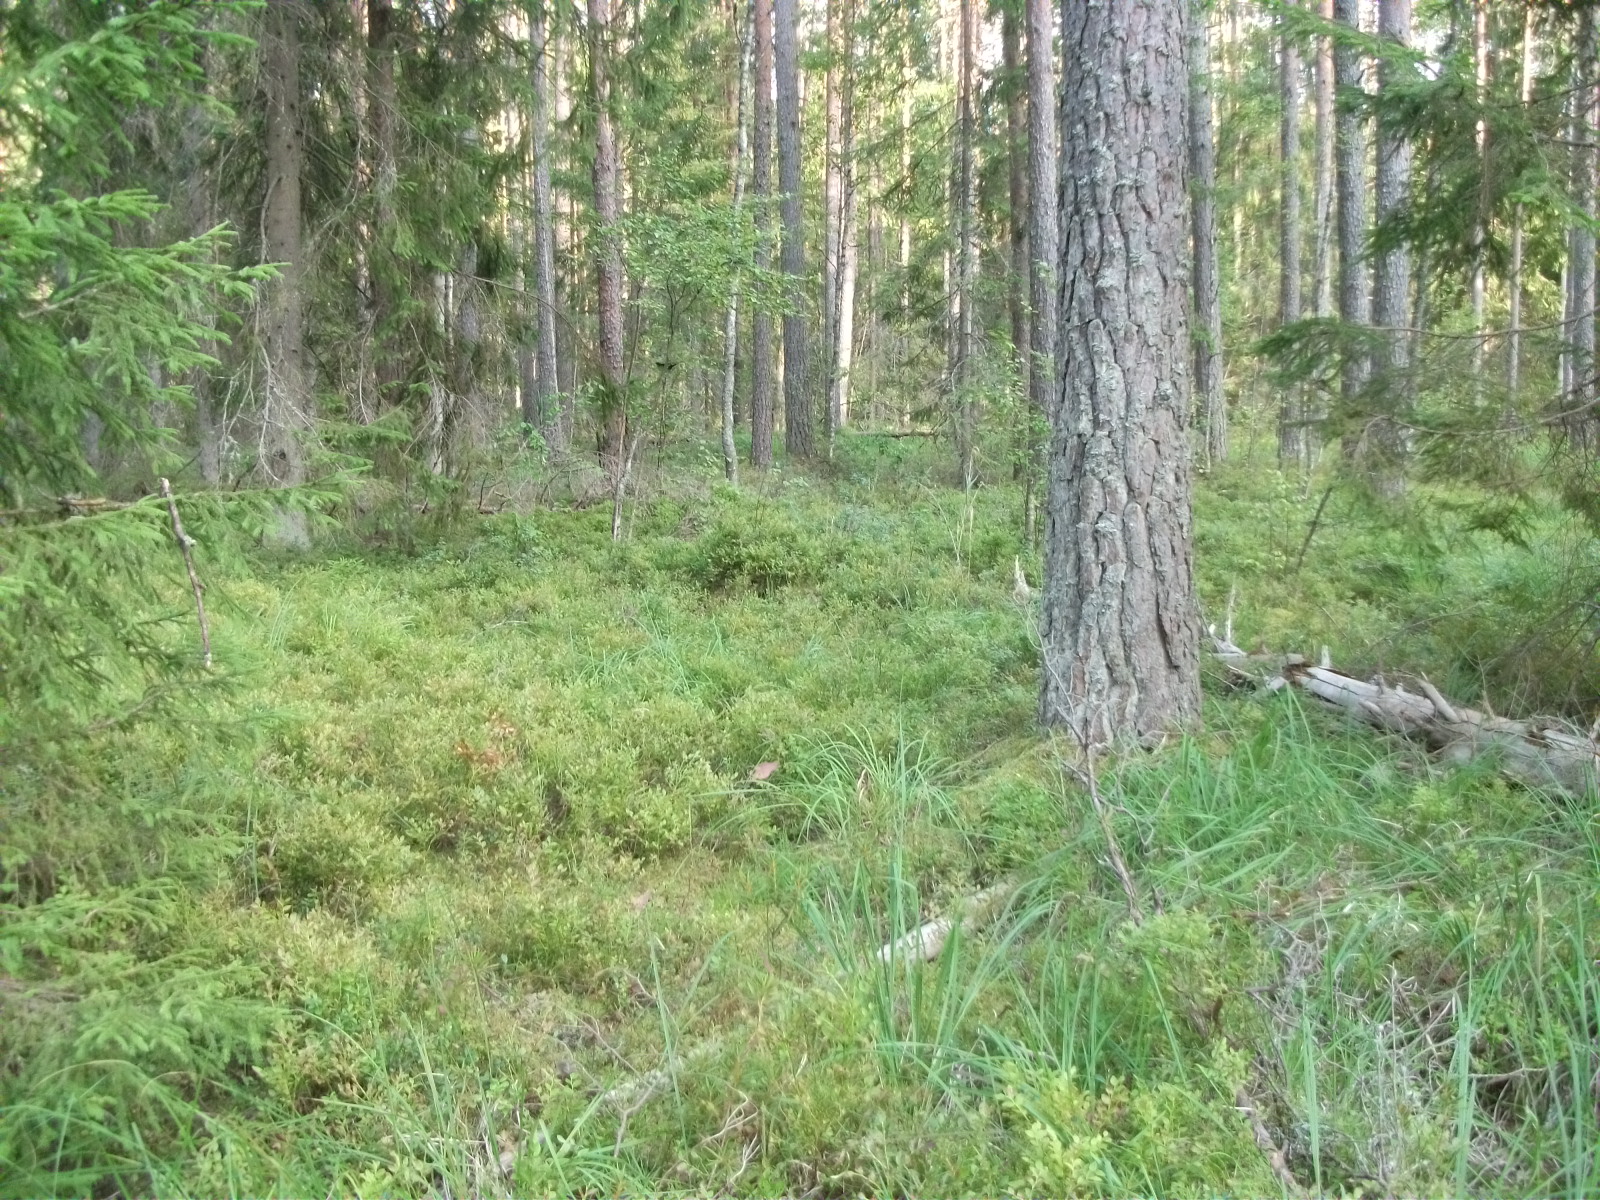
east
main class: Woodland
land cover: Other coniferous woodland
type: hemiboreal forest and nemoral coniferous forest and mixed broadleaved-coniferous forest
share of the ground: 50 - 75 %
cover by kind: coniferous forest trees 70 %, lichens and mosses 20 %, herbaceous plants 10 %
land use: Forestry
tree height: > 5 m
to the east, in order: Other coniferous woodland; Spruce dominated coniferous woodland; Ditches and canals; Spruce dominated coniferous woodland
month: August
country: LV
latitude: 56.8533
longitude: 26.5287
